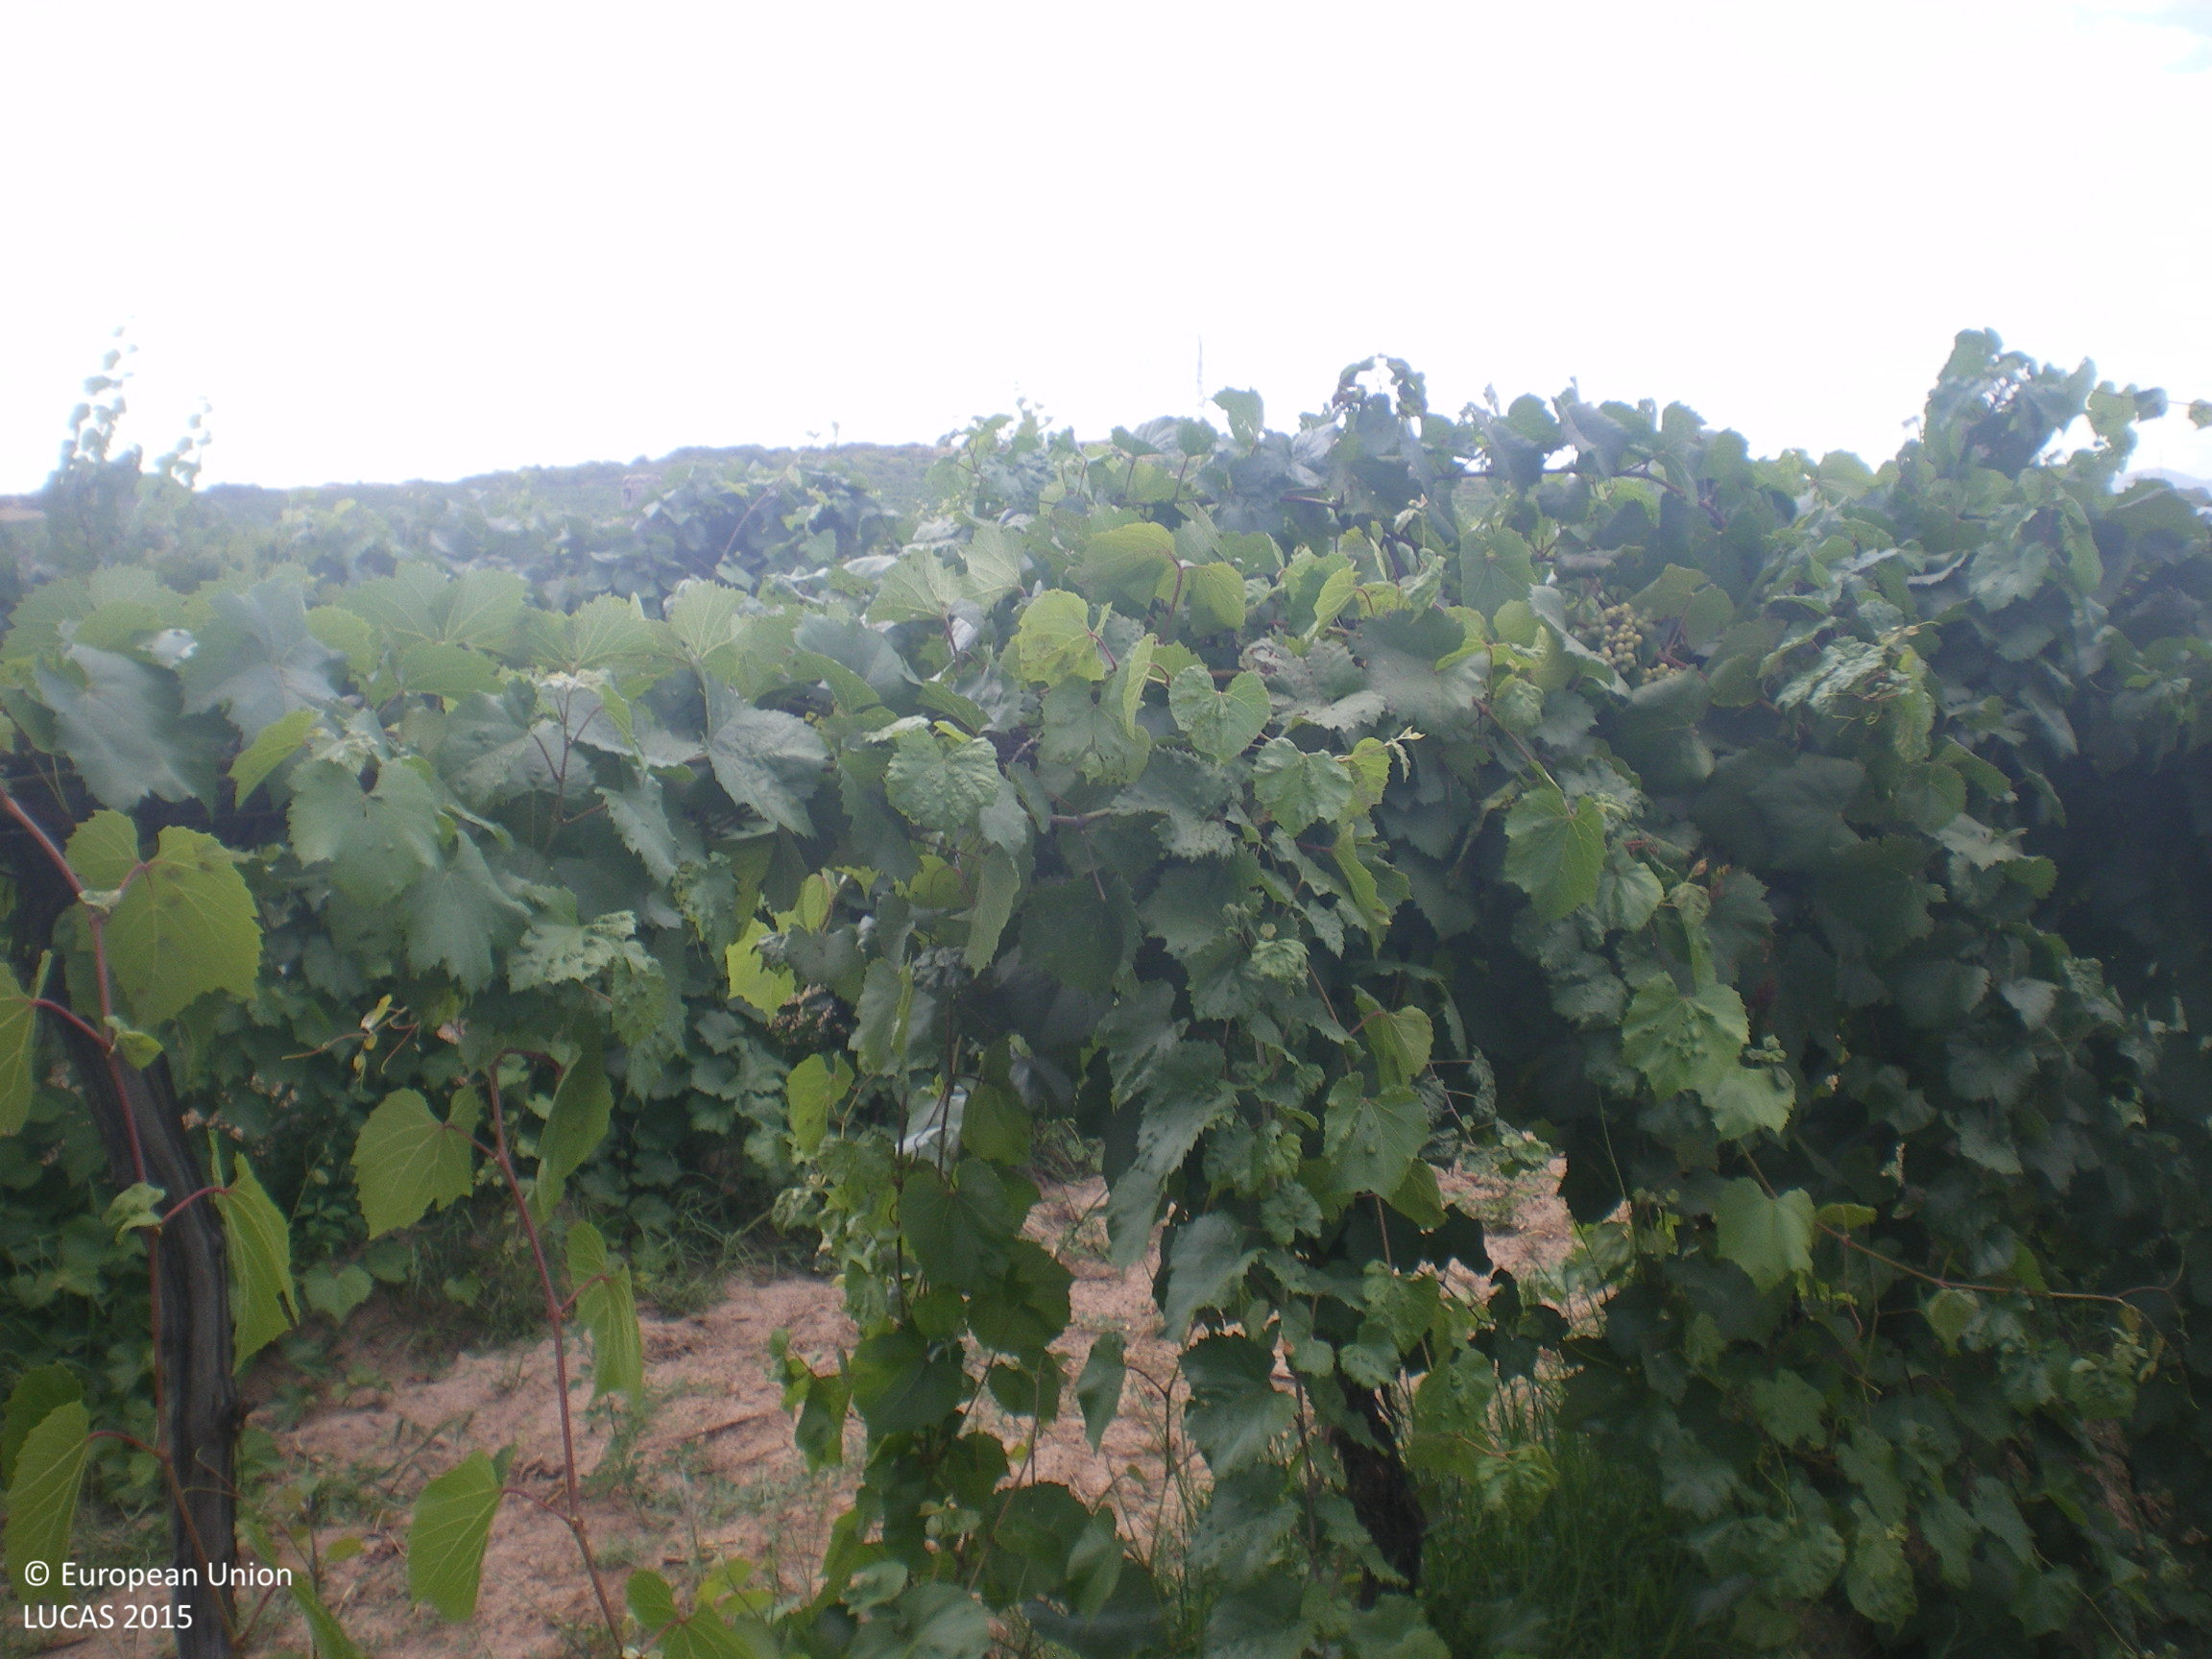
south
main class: Cropland
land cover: Vineyards
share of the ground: 50 - 75 %
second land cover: Other bare soil
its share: > 75 %
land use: Agriculture (excluding fallow land and kitchen gardens)
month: August
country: BG
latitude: 42.6105
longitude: 25.8404
